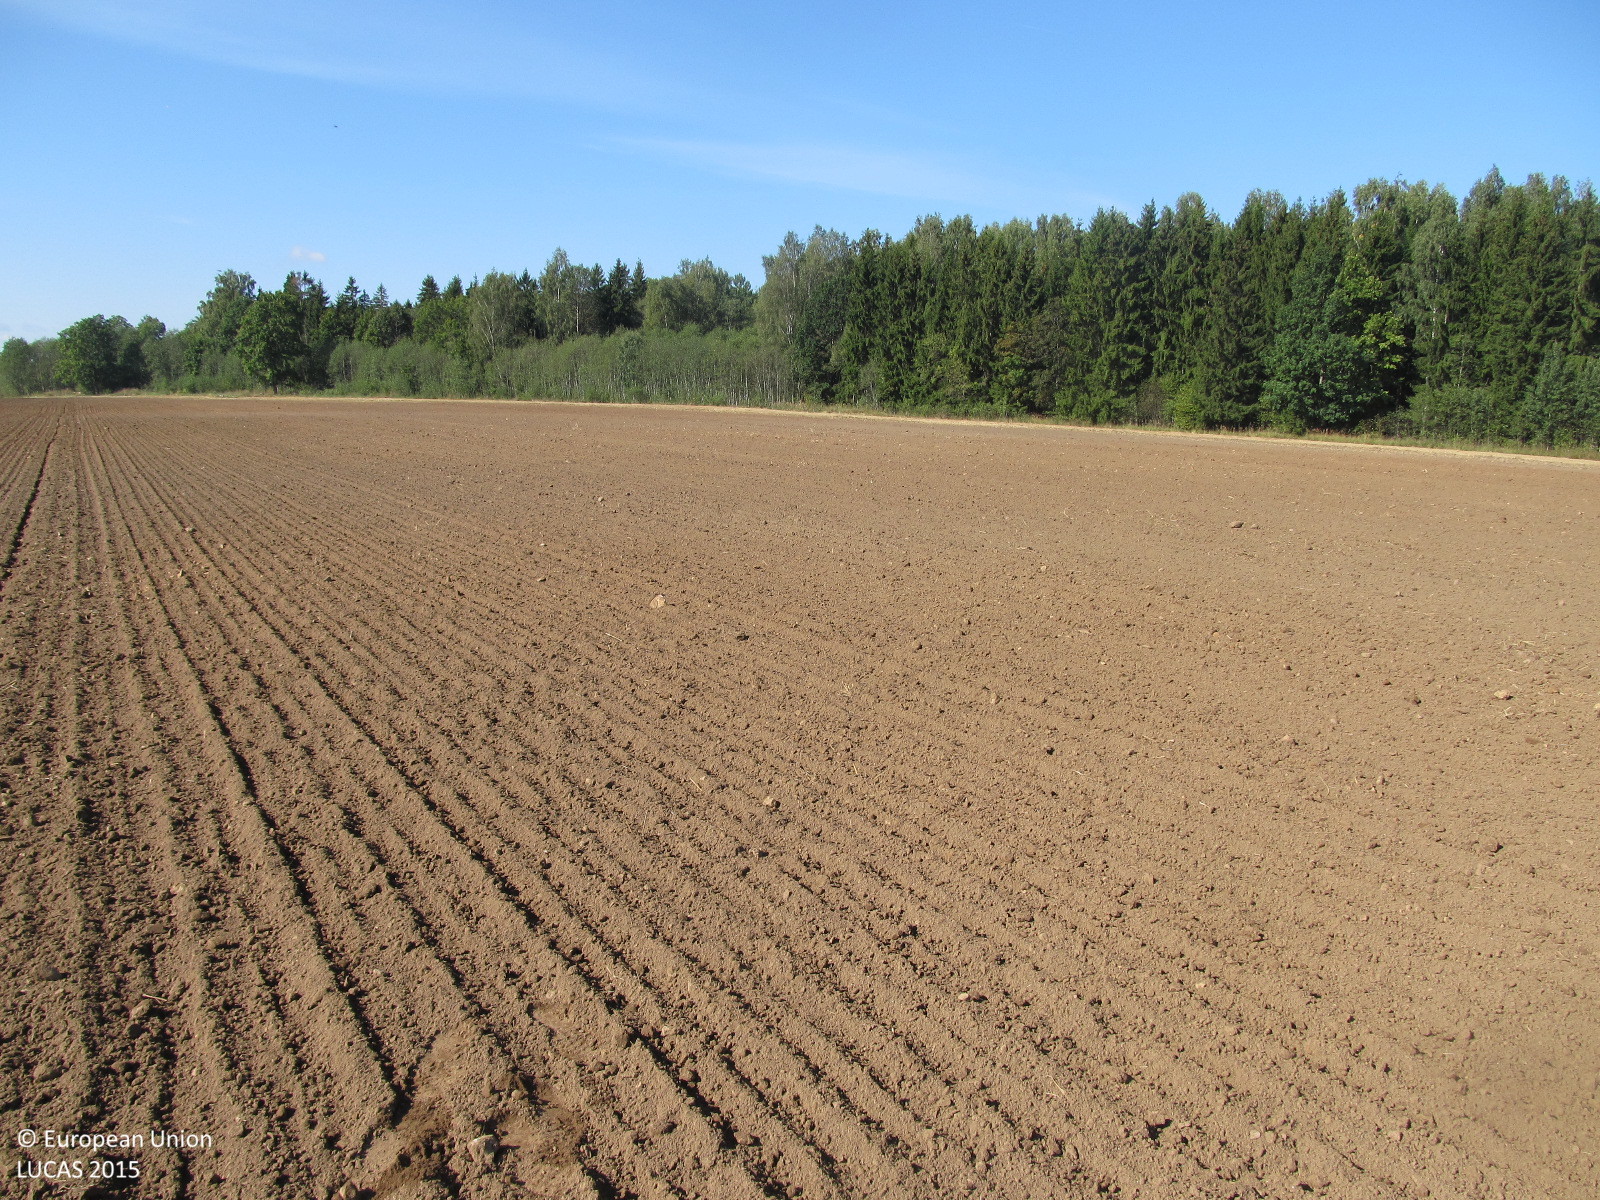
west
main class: Cropland
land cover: Common wheat
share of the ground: > 75 %
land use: Agriculture (excluding fallow land and kitchen gardens)
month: September
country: LT
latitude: 56.1471
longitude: 22.9594
